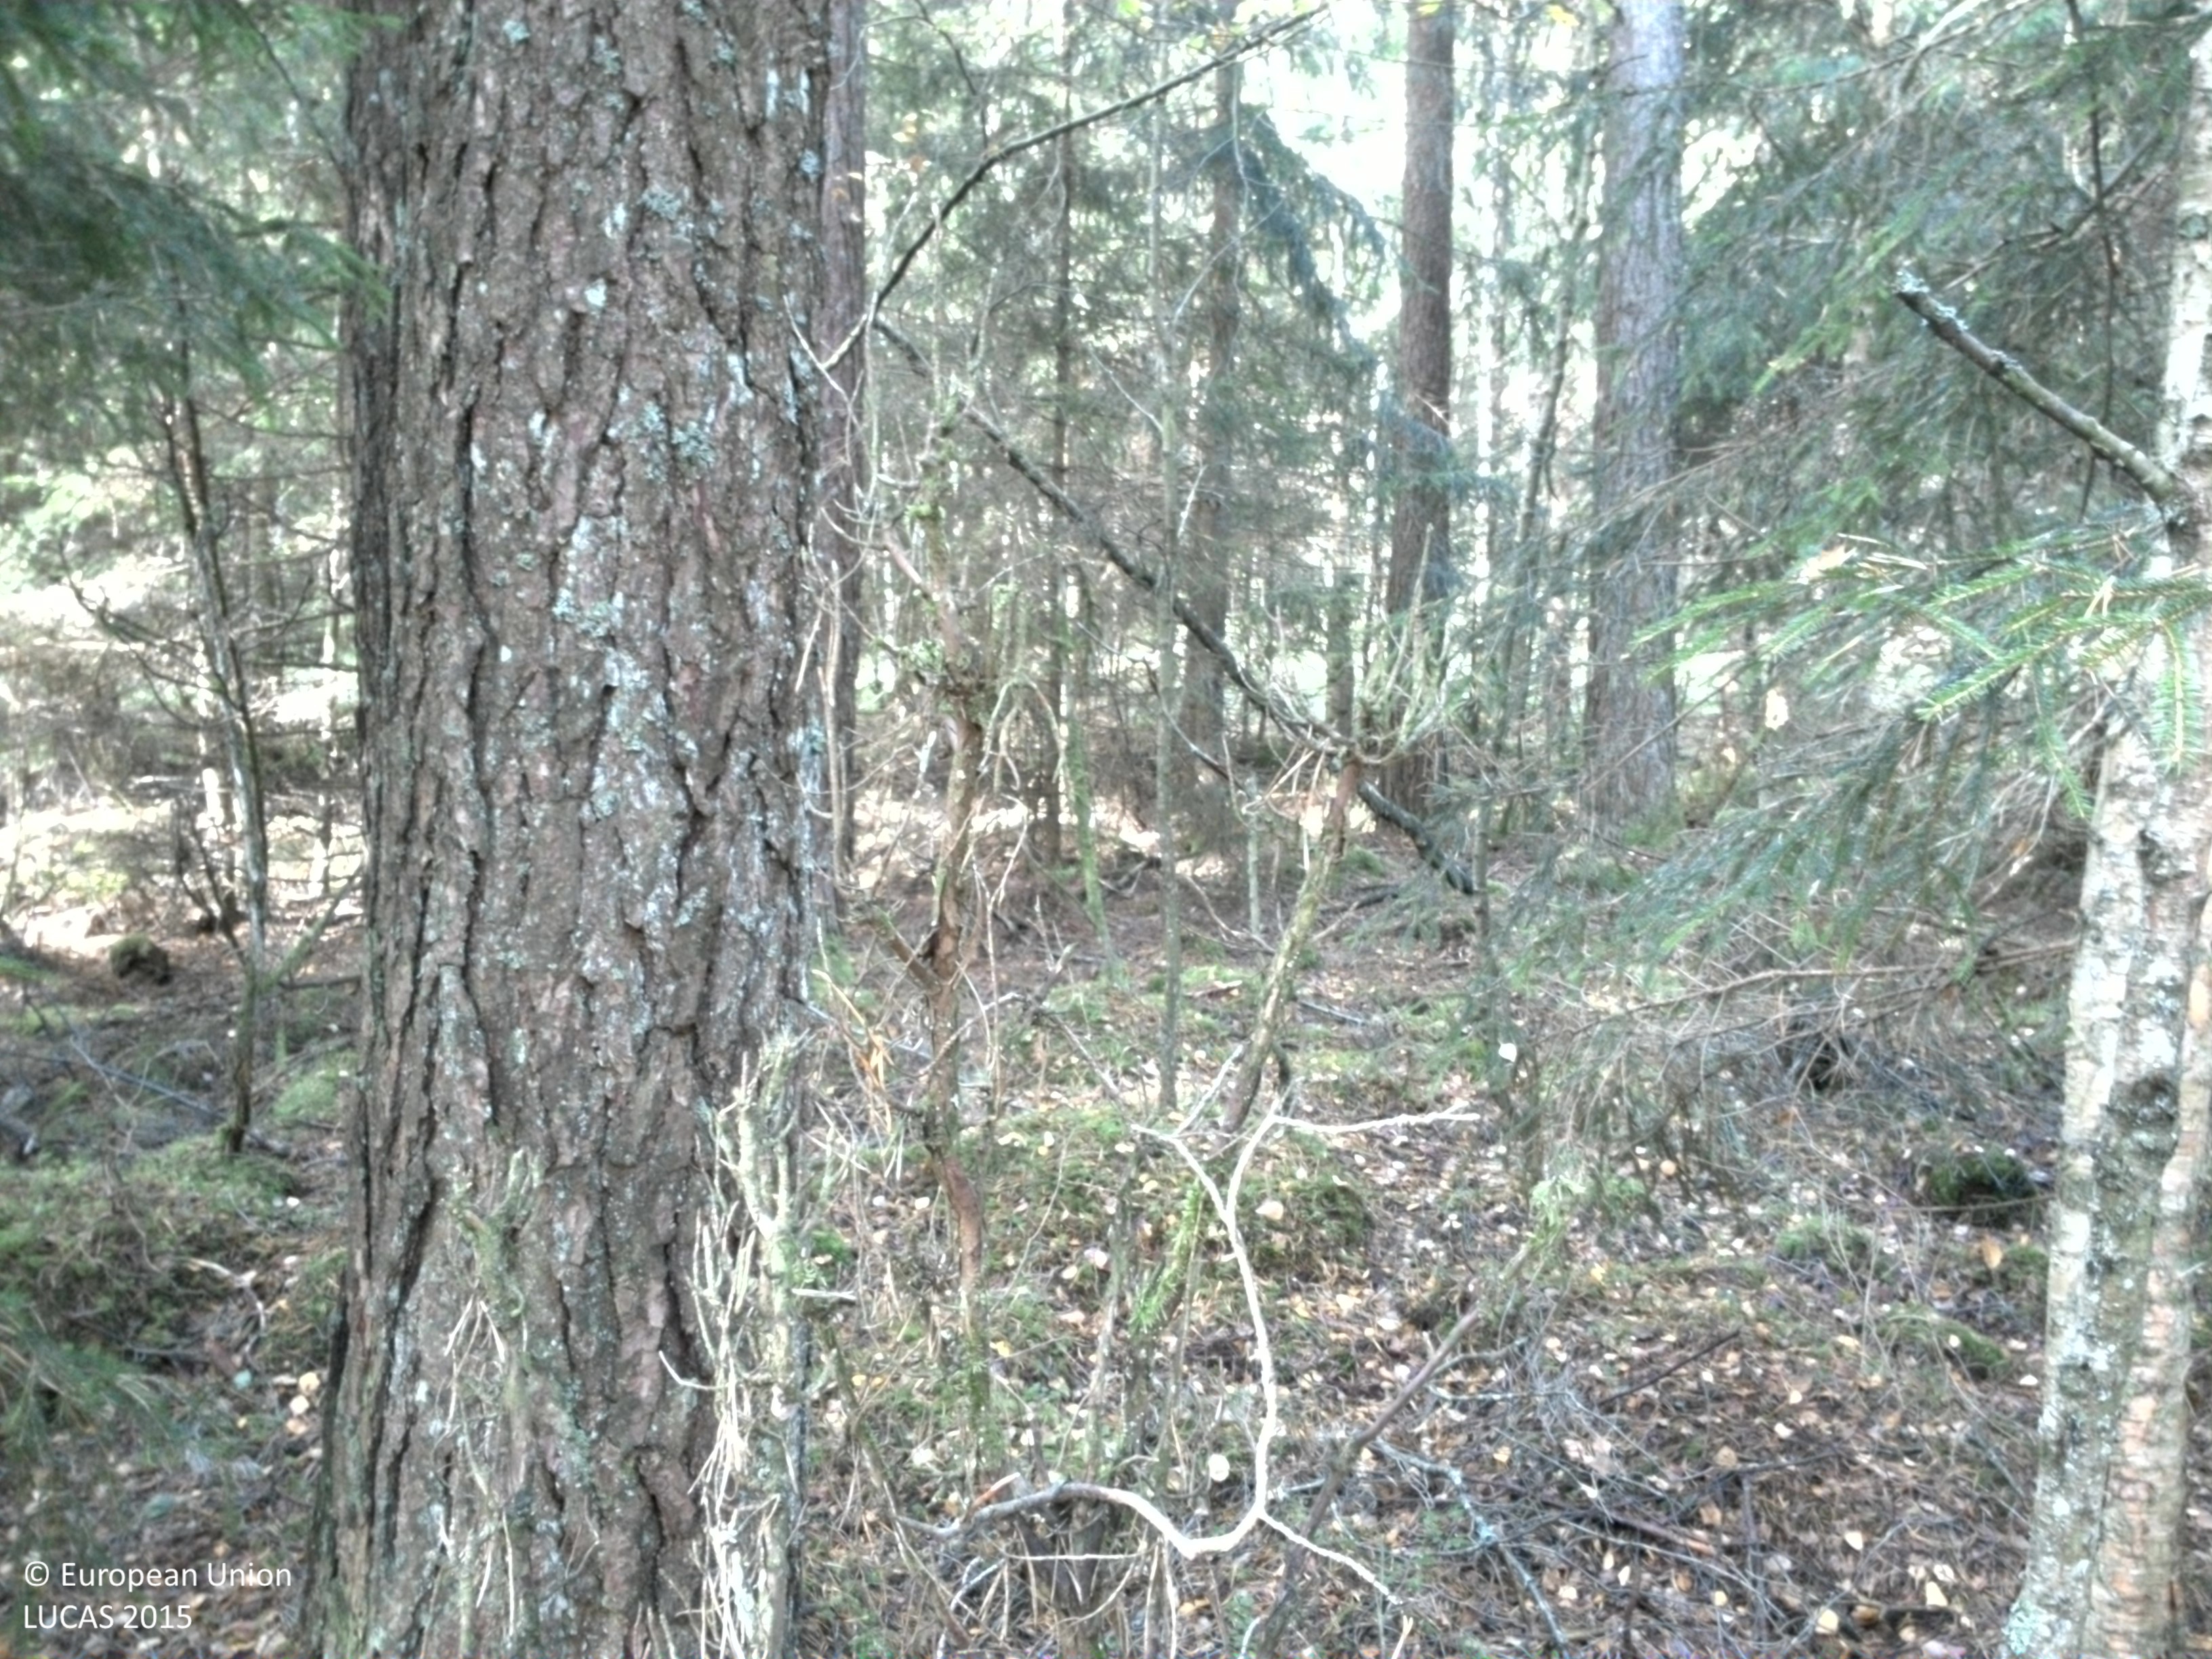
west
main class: Woodland
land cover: Pine dominated coniferous woodland
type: boreal forest
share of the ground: > 75 %
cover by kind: coniferous forest trees 85 %, broadleaved forest trees 5 %, shrubs 5 %, lichens and mosses 5 %
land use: Forestry
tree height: > 5 m
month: September
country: SE
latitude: 58.0032
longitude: 13.1253
